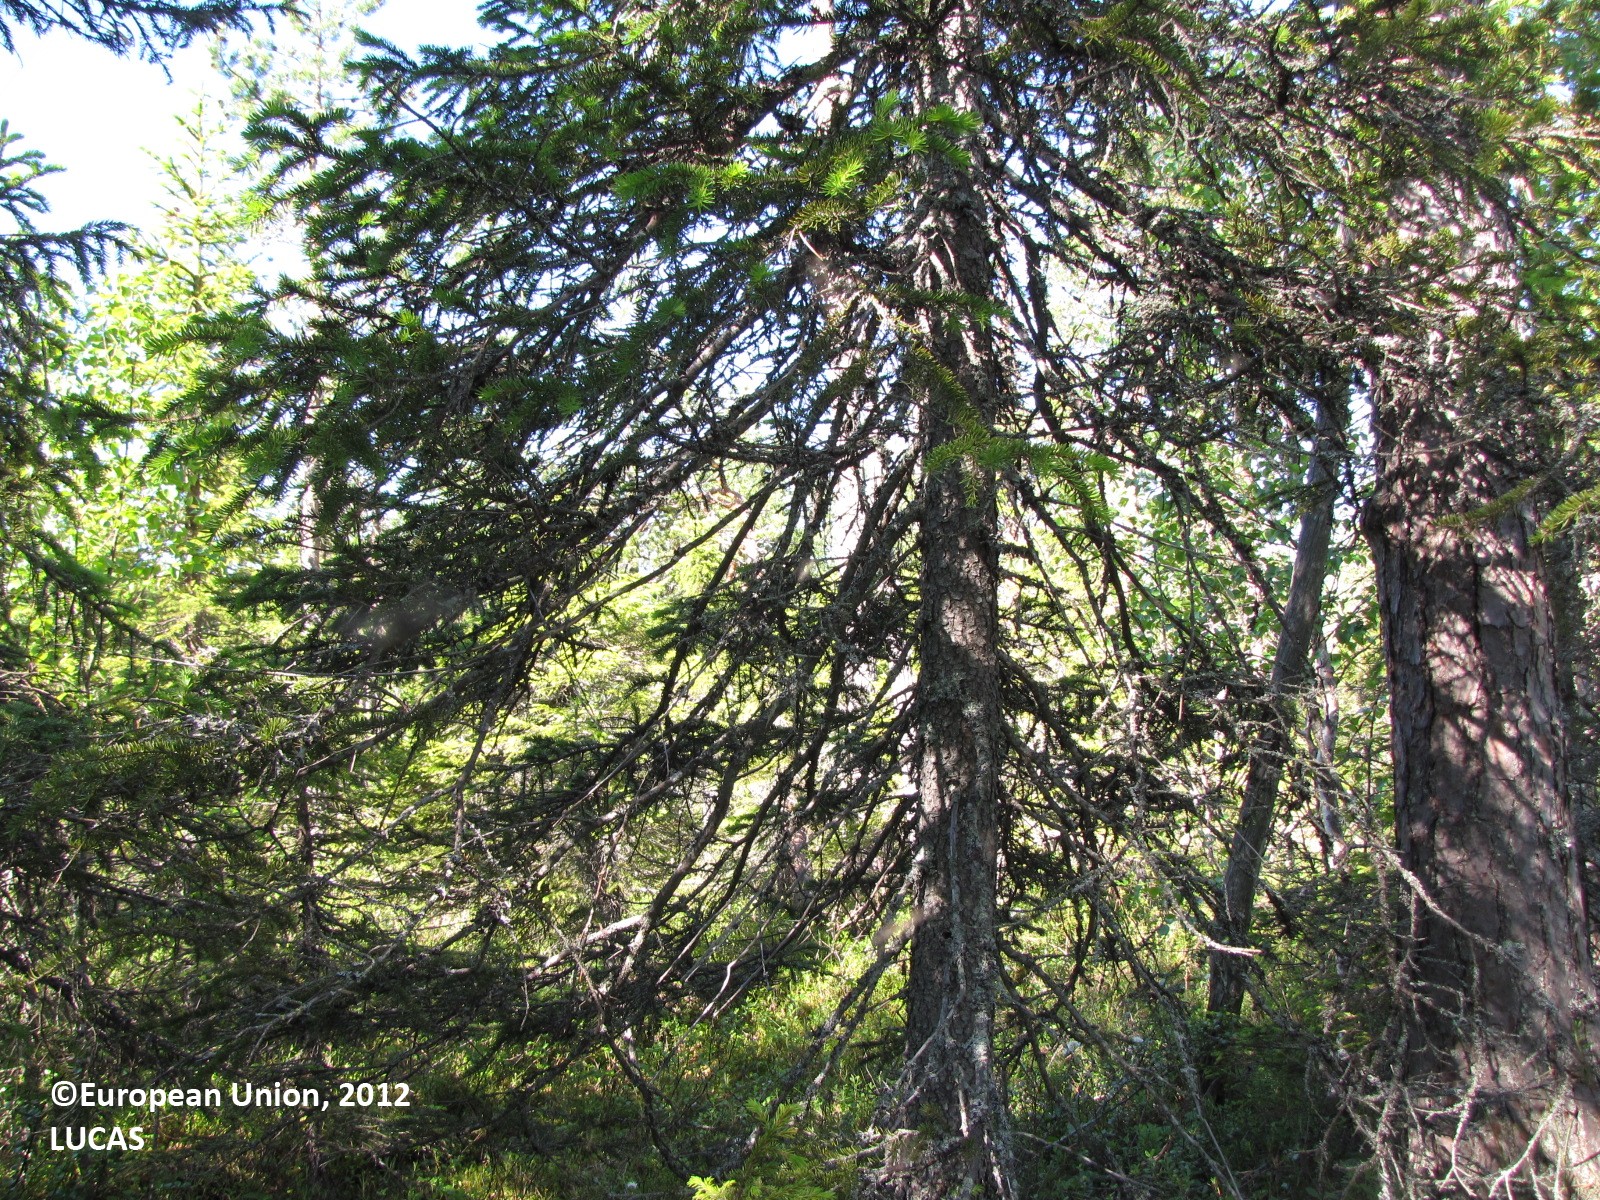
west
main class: Woodland
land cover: Spruce dominated mixed woodland
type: boreal forest
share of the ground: 10 - 25 %
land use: Forestry
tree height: > 5 m
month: July
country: FI
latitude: 66.4308
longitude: 24.8207
